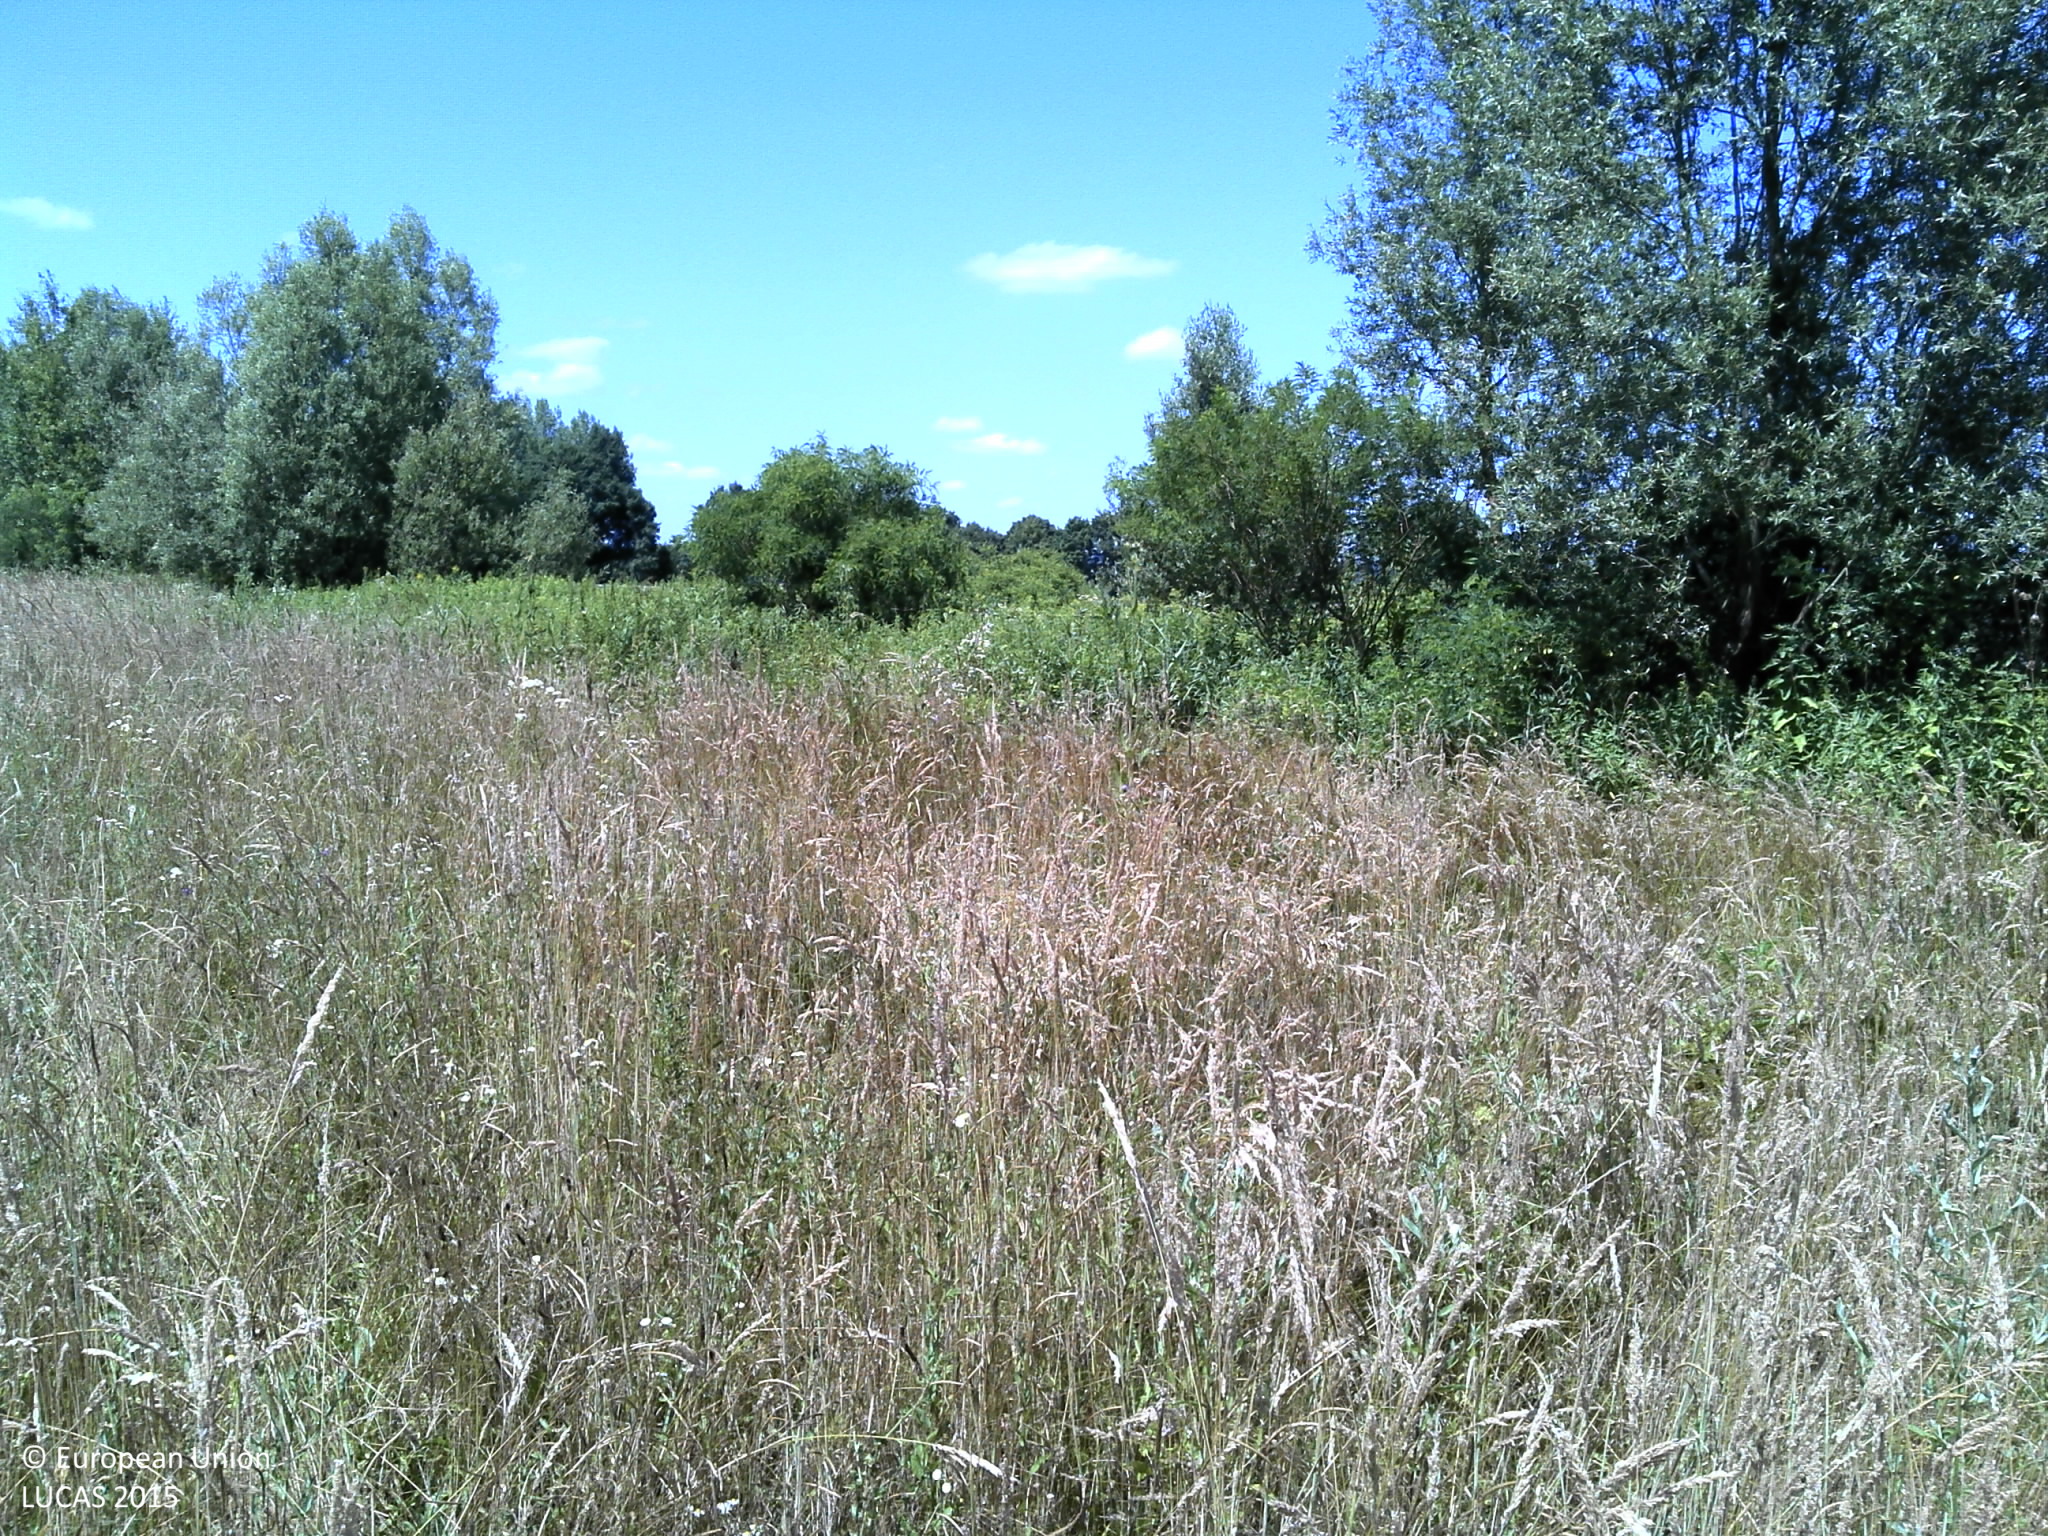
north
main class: Grassland
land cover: Grassland without tree/shrub cover
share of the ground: > 75 %
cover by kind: herbaceous plants 100 %
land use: Semi-natural and natural areas not in use
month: July
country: HR
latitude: 45.4273
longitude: 16.8368
